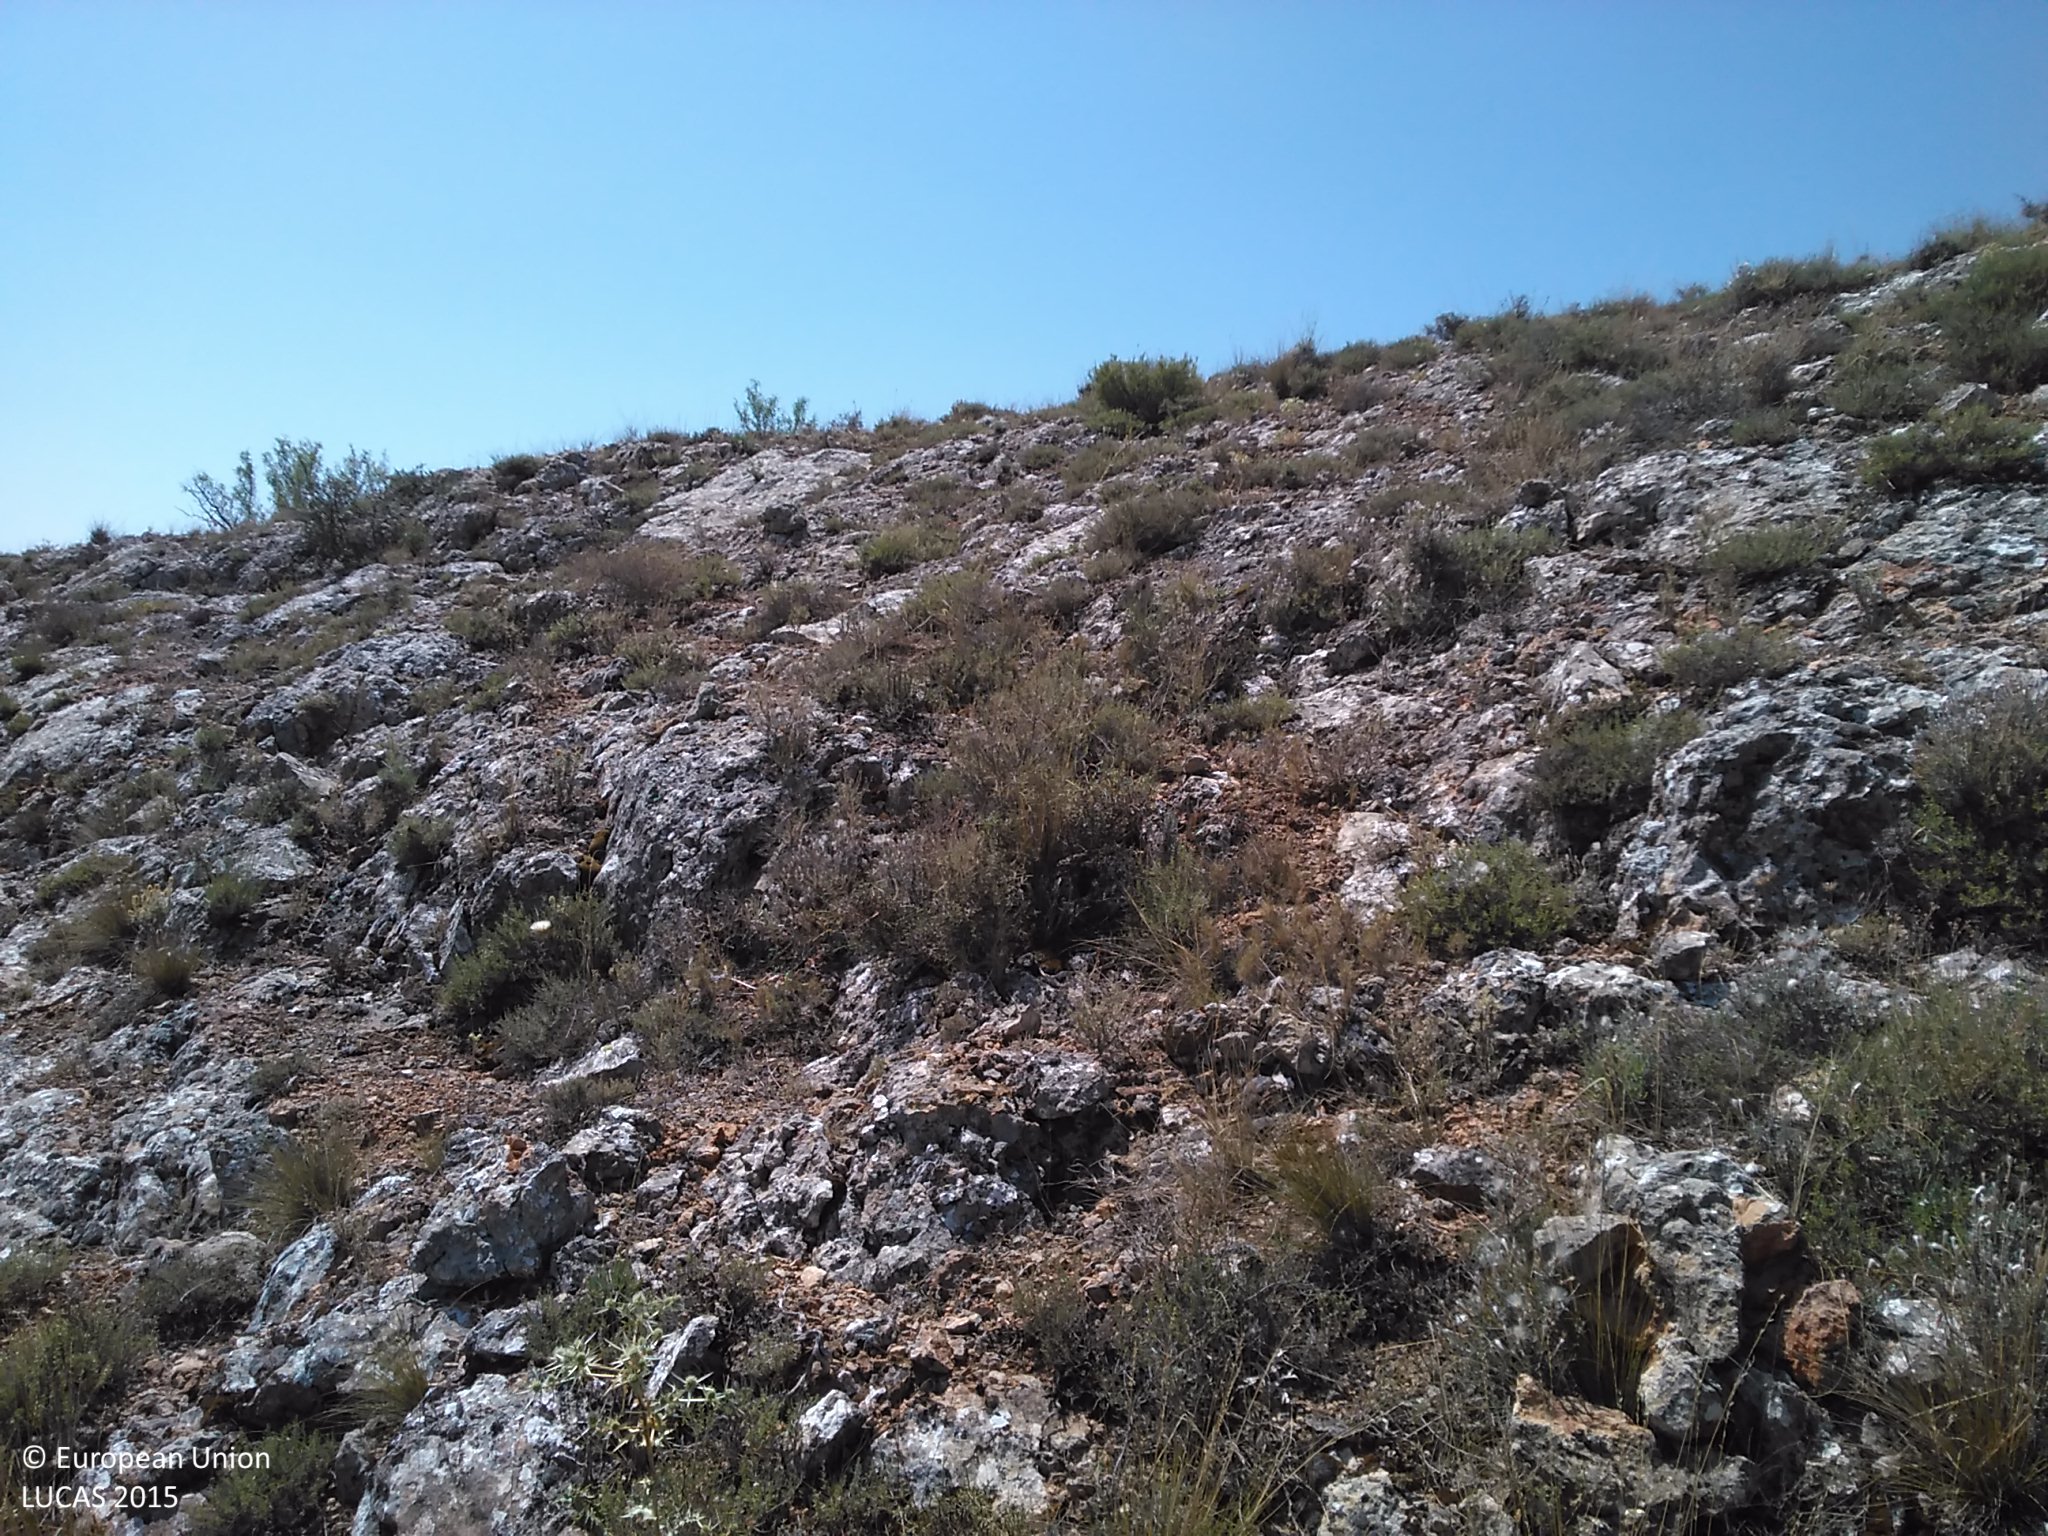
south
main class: Shrubland
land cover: Shrubland without tree cover
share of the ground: 25 - 50 %
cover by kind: shrubs 40 %, consolidated bare surface 25 %, unconsolidated bare surface 25 %, herbaceous plants 5 %, lichens and mosses 5 %
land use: Semi-natural and natural areas not in use
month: July
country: ES
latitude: 41.5117
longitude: -1.9031
